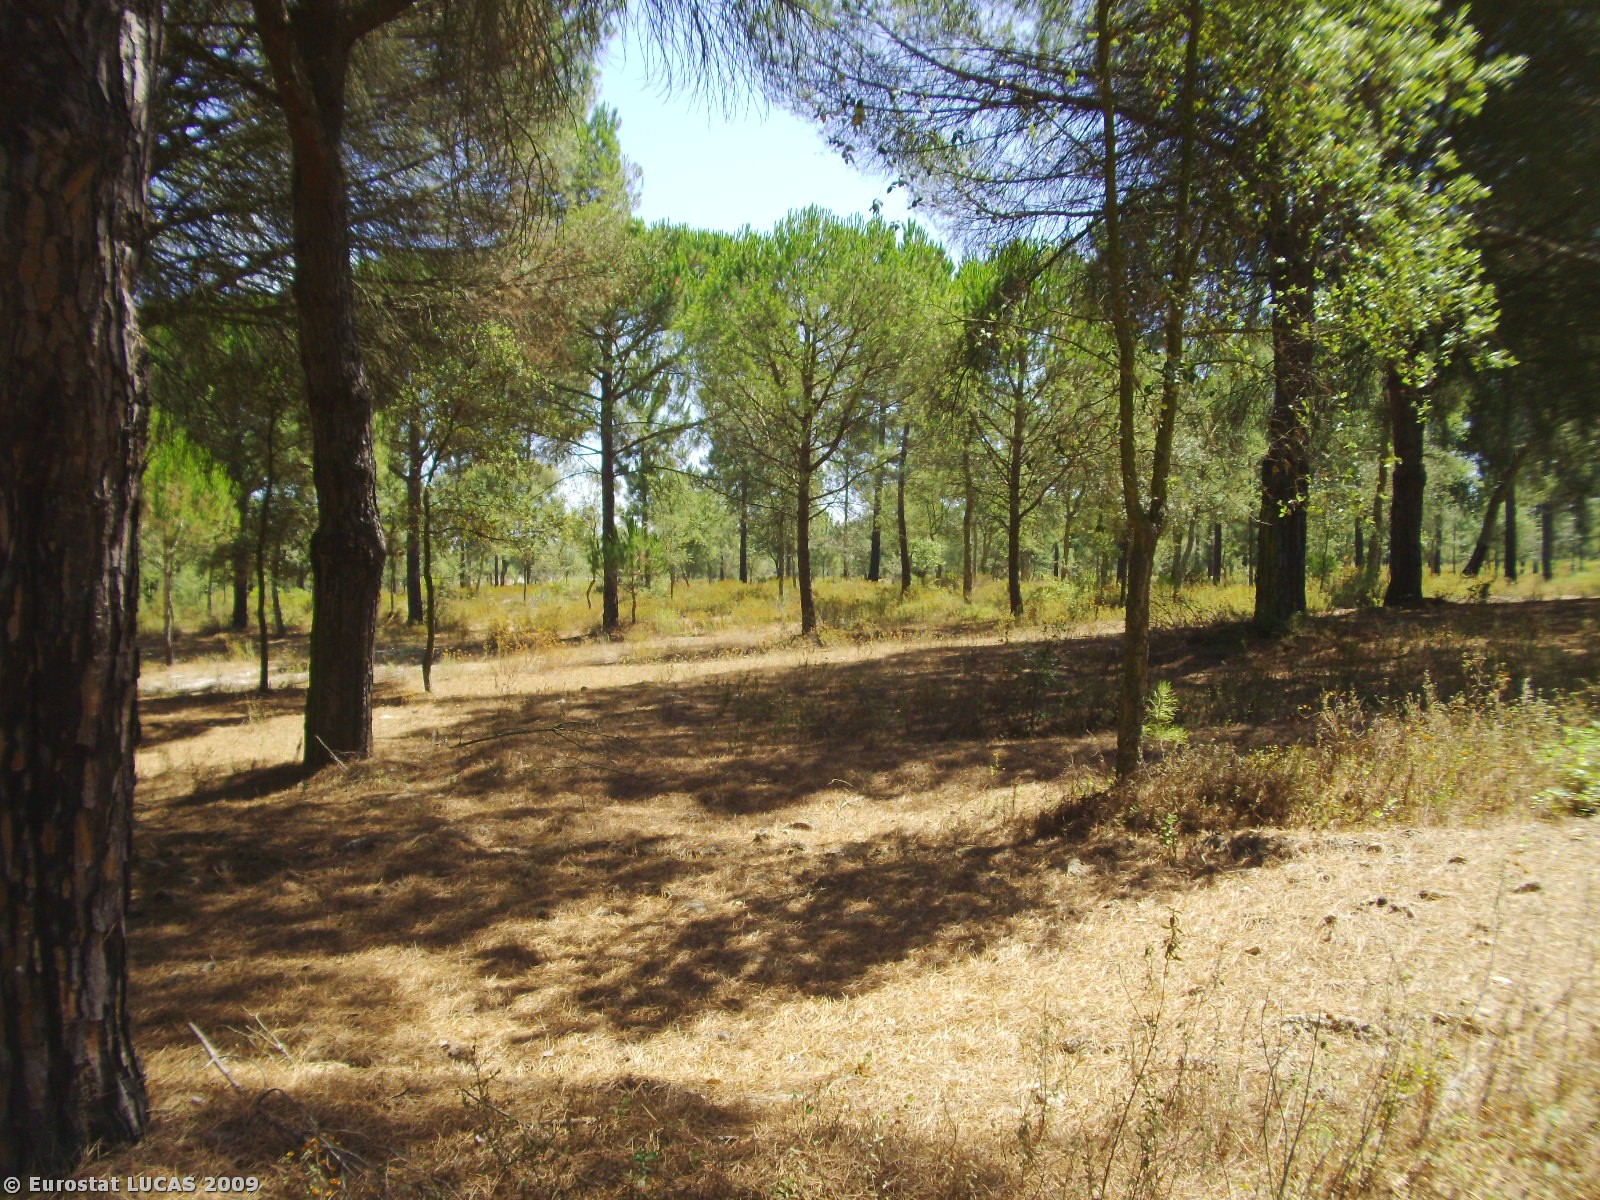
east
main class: Woodland
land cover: Coniferous woodland
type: coniferous forest of the mediterranean region
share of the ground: 50 - 75 %
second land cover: Spontaneously vegetated surfaces
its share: 10 - 25 %
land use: Forestry
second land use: Fallow land
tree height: > 5 m
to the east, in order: Coniferous woodland; Spontaneously vegetated surfaces; Coniferous woodland; Broadleaved woodland
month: August
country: PT
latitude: 38.5912
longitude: -8.7407
